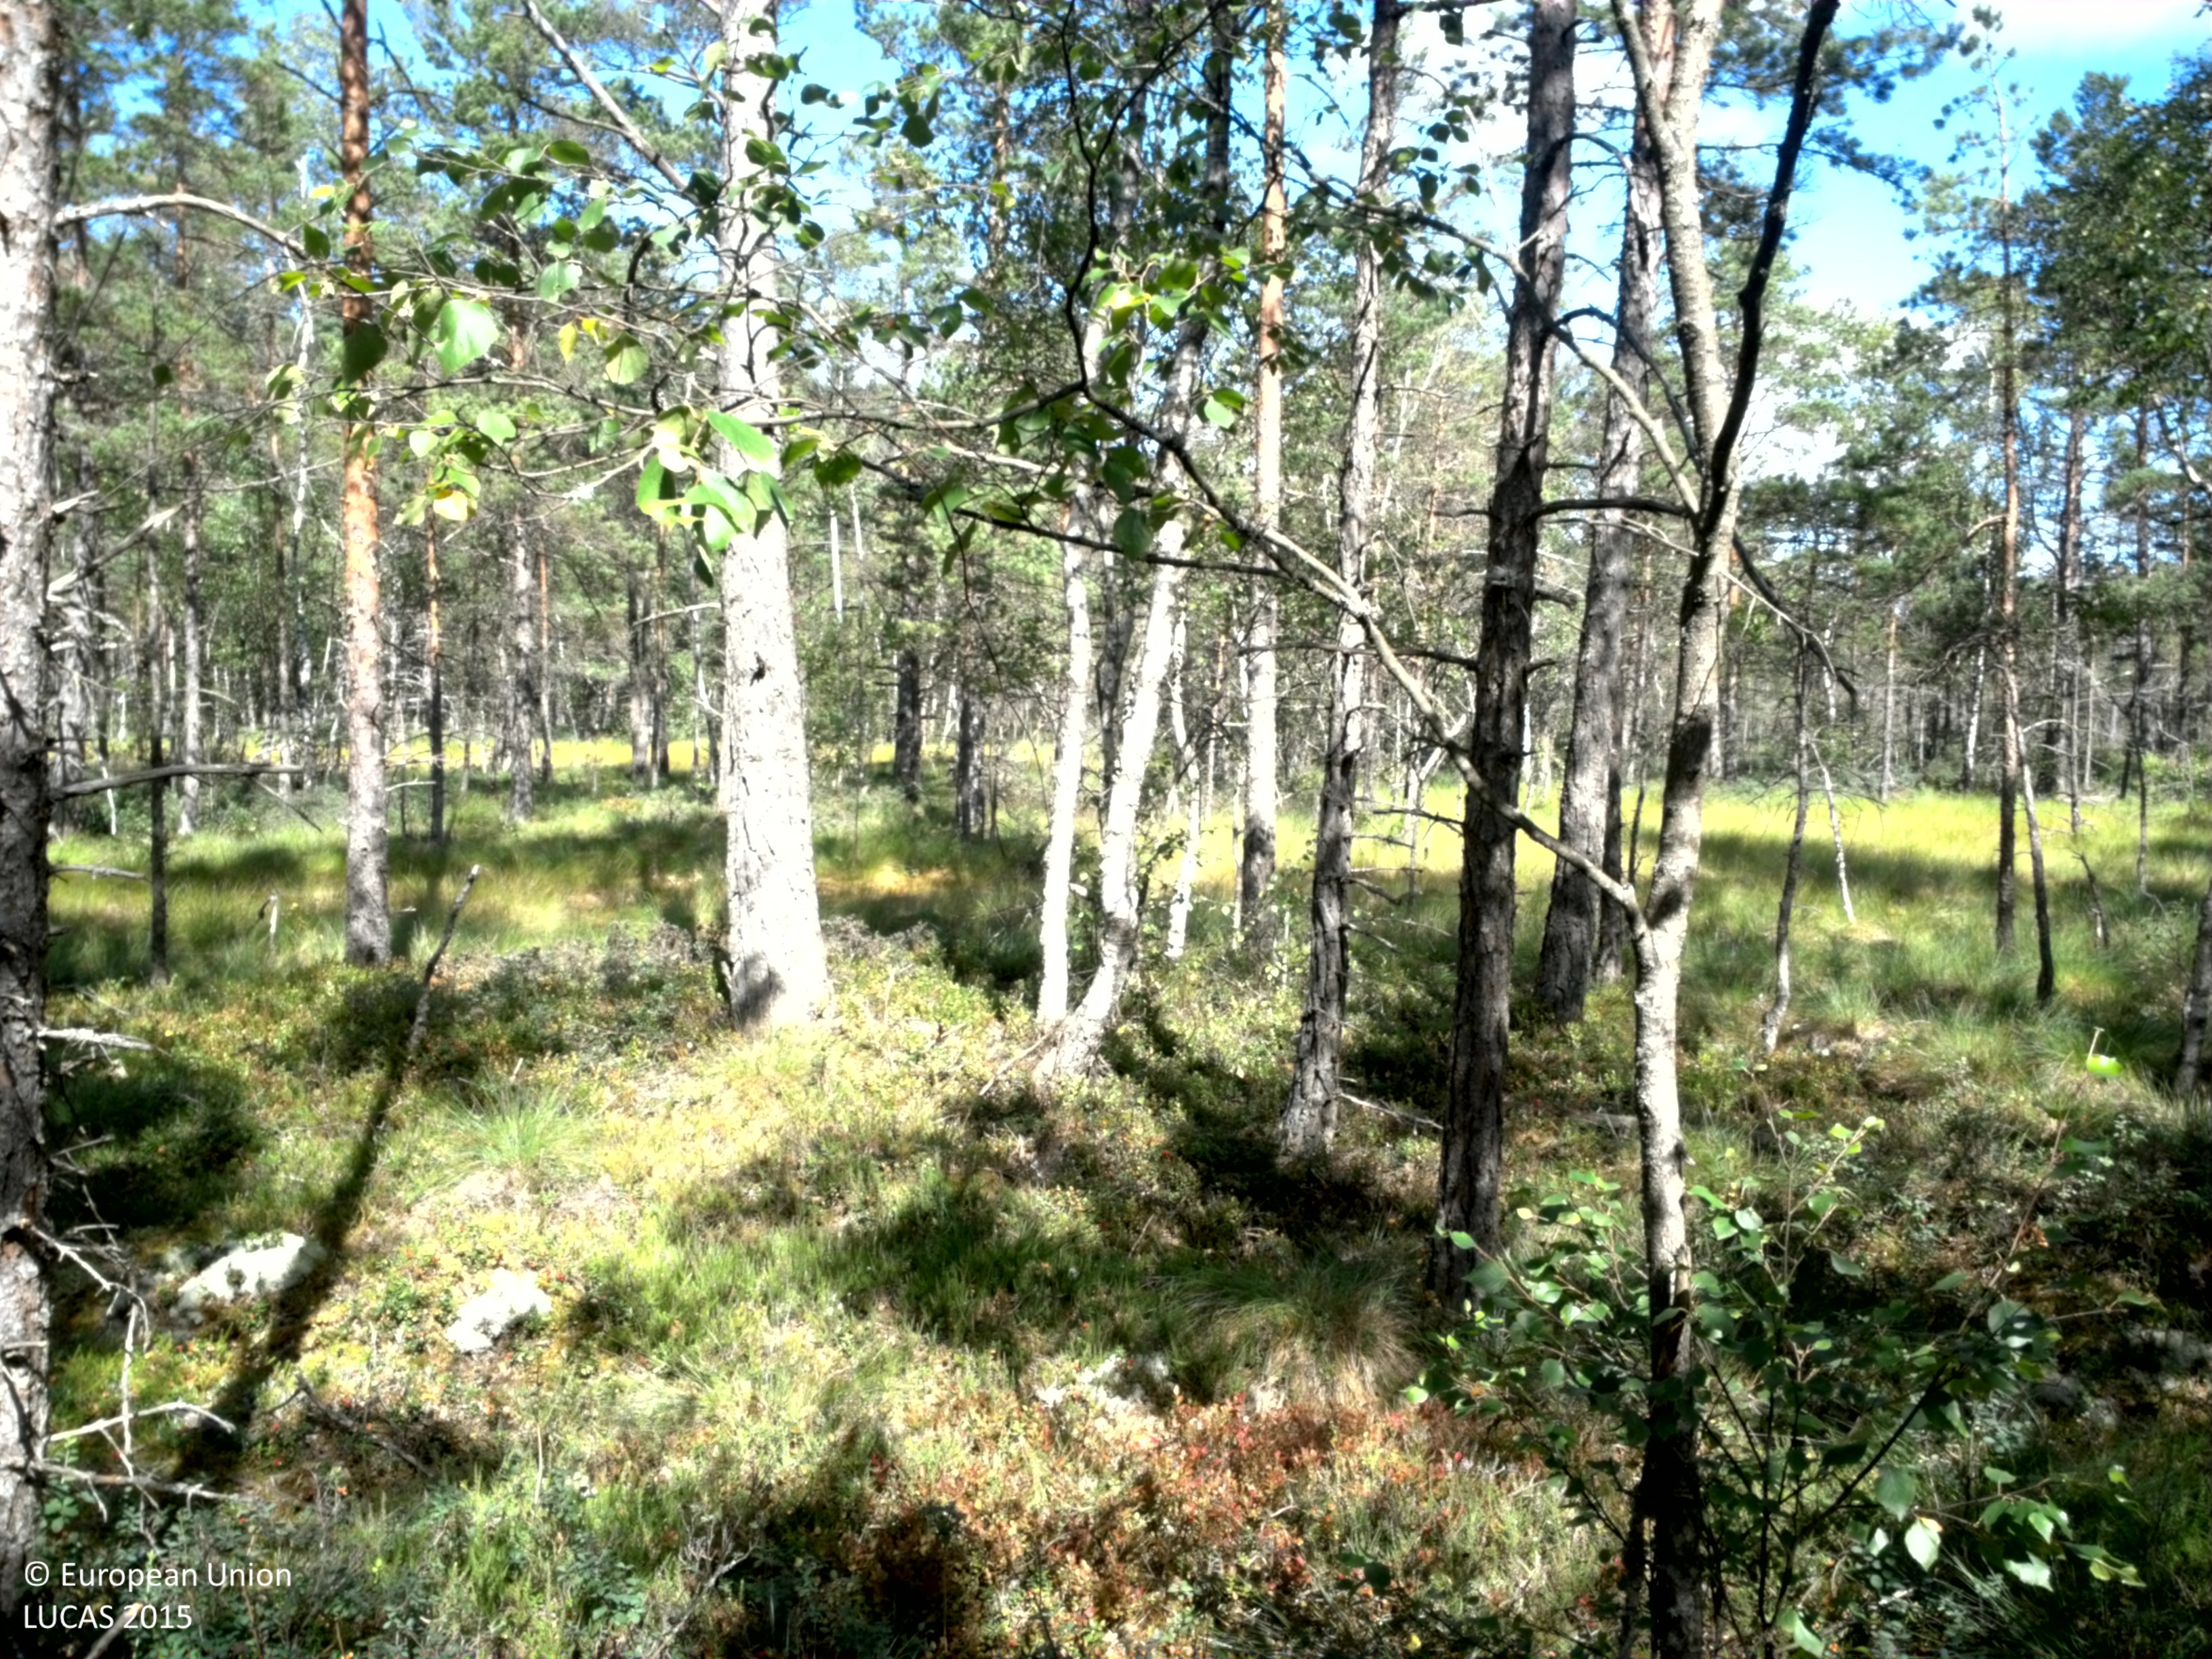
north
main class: Woodland
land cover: Pine dominated mixed woodland
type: boreal forest
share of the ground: 25 - 50 %
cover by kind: coniferous forest trees 30 %, shrubs 30 %, broadleaved forest trees 20 %, lichens and mosses 15 %, herbaceous plants 5 %
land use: Semi-natural and natural areas not in use
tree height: > 5 m
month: August
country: SE
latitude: 58.2163
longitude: 13.2458
